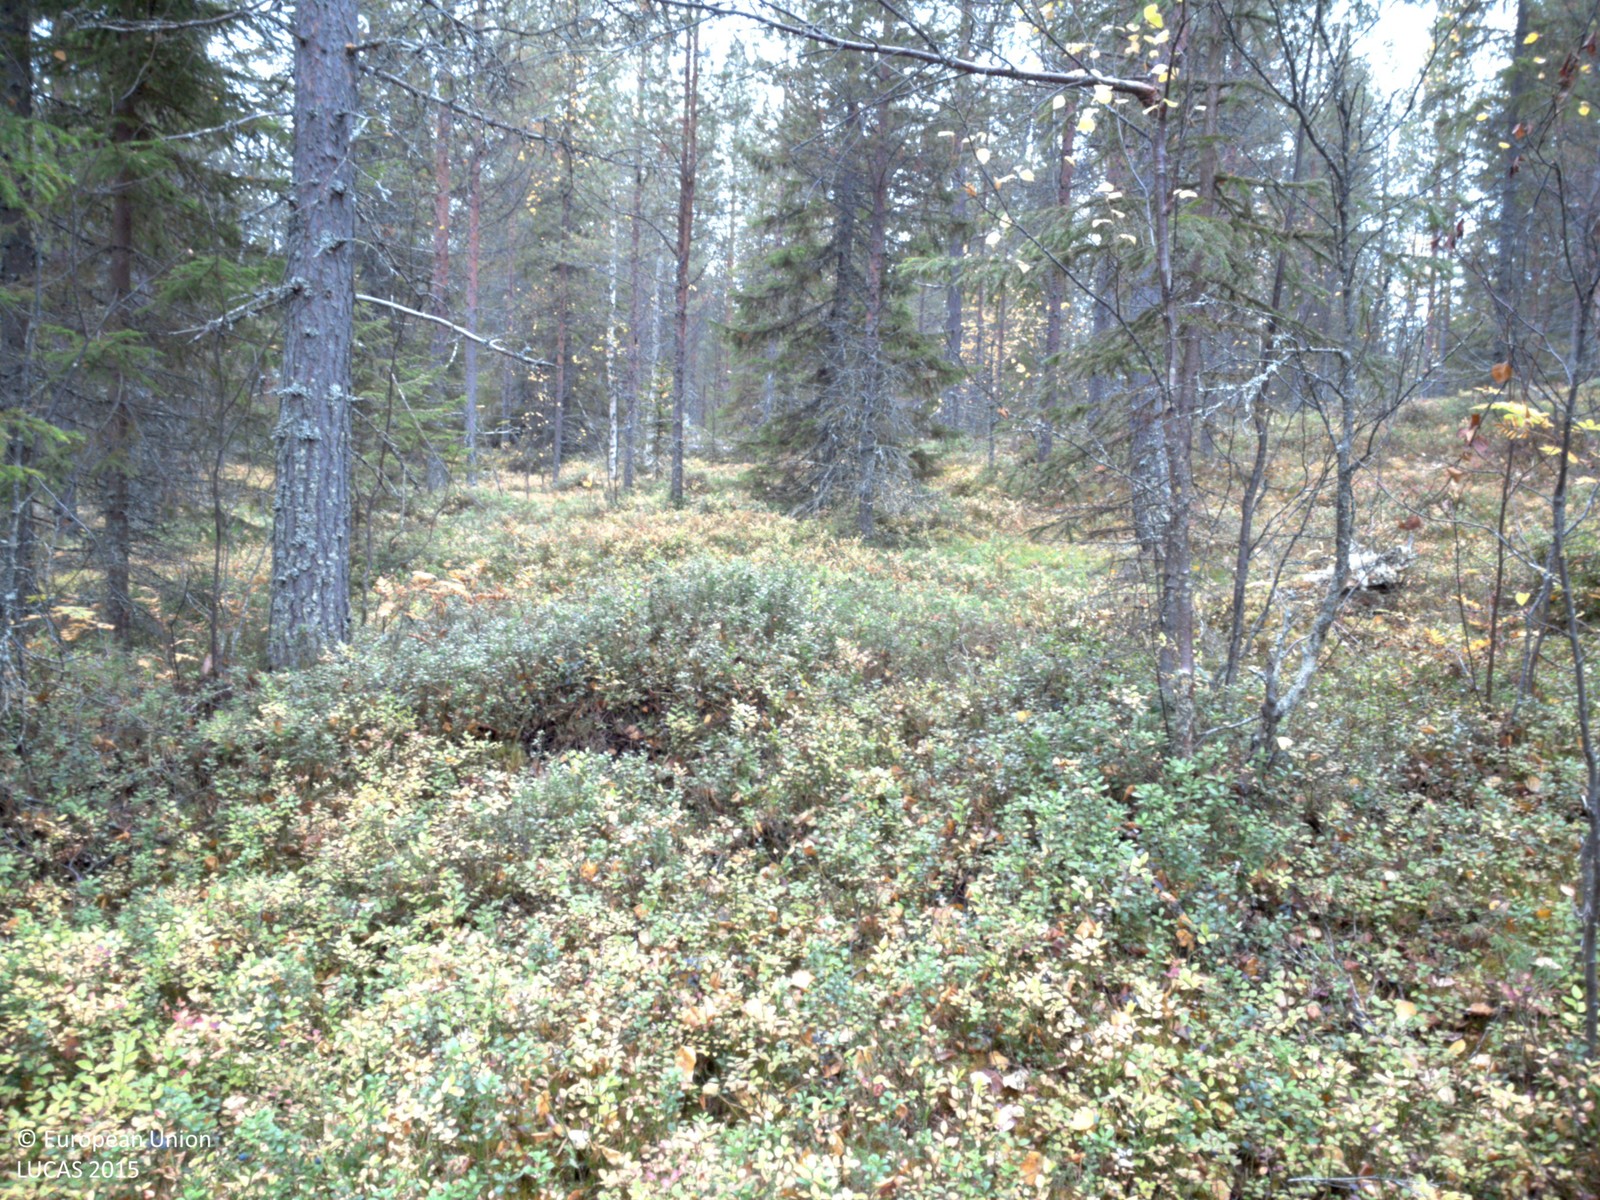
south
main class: Woodland
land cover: Other coniferous woodland
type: boreal forest
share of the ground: > 75 %
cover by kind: coniferous forest trees 75 %, shrubs 15 %, herbaceous plants 5 %, lichens and mosses 5 %
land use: Forestry
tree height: > 5 m
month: October
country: SE
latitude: 65.0125
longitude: 18.3870
